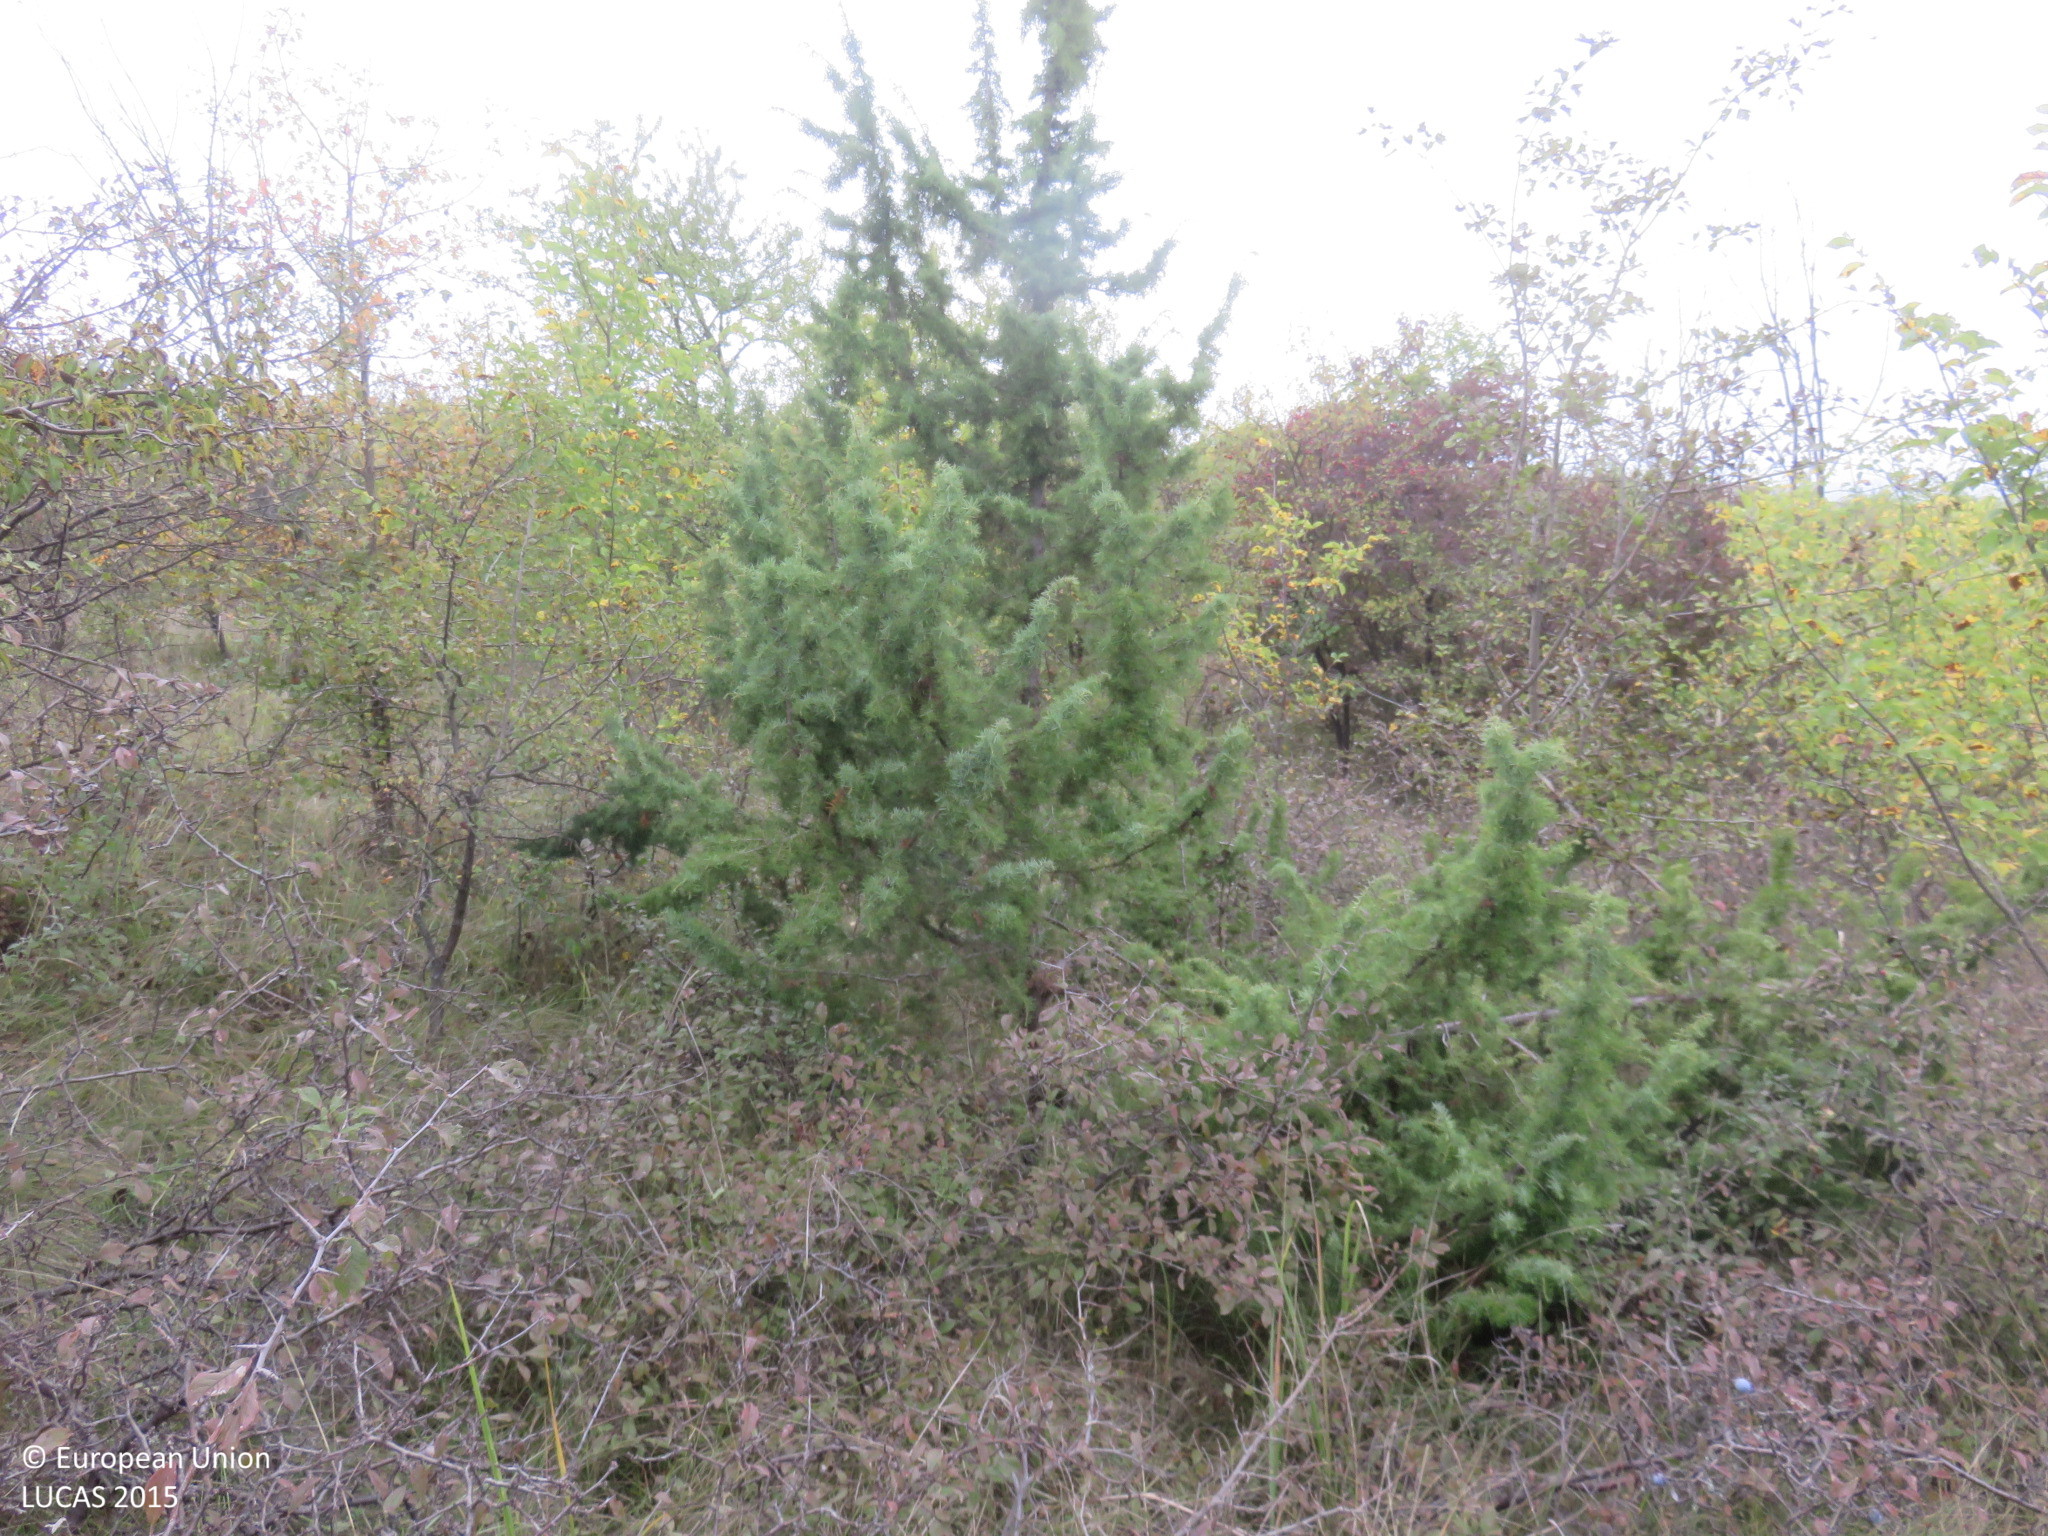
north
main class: Woodland
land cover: Broadleaved woodland
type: mesophytic deciduous forest
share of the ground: 10 - 25 %
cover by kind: shrubs 40 %, herbaceous plants 40 %, broadleaved forest trees 15 %, coniferous forest trees 5 %
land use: Semi-natural and natural areas not in use
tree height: < 5 m
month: October
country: BG
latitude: 42.9933
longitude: 25.1428
